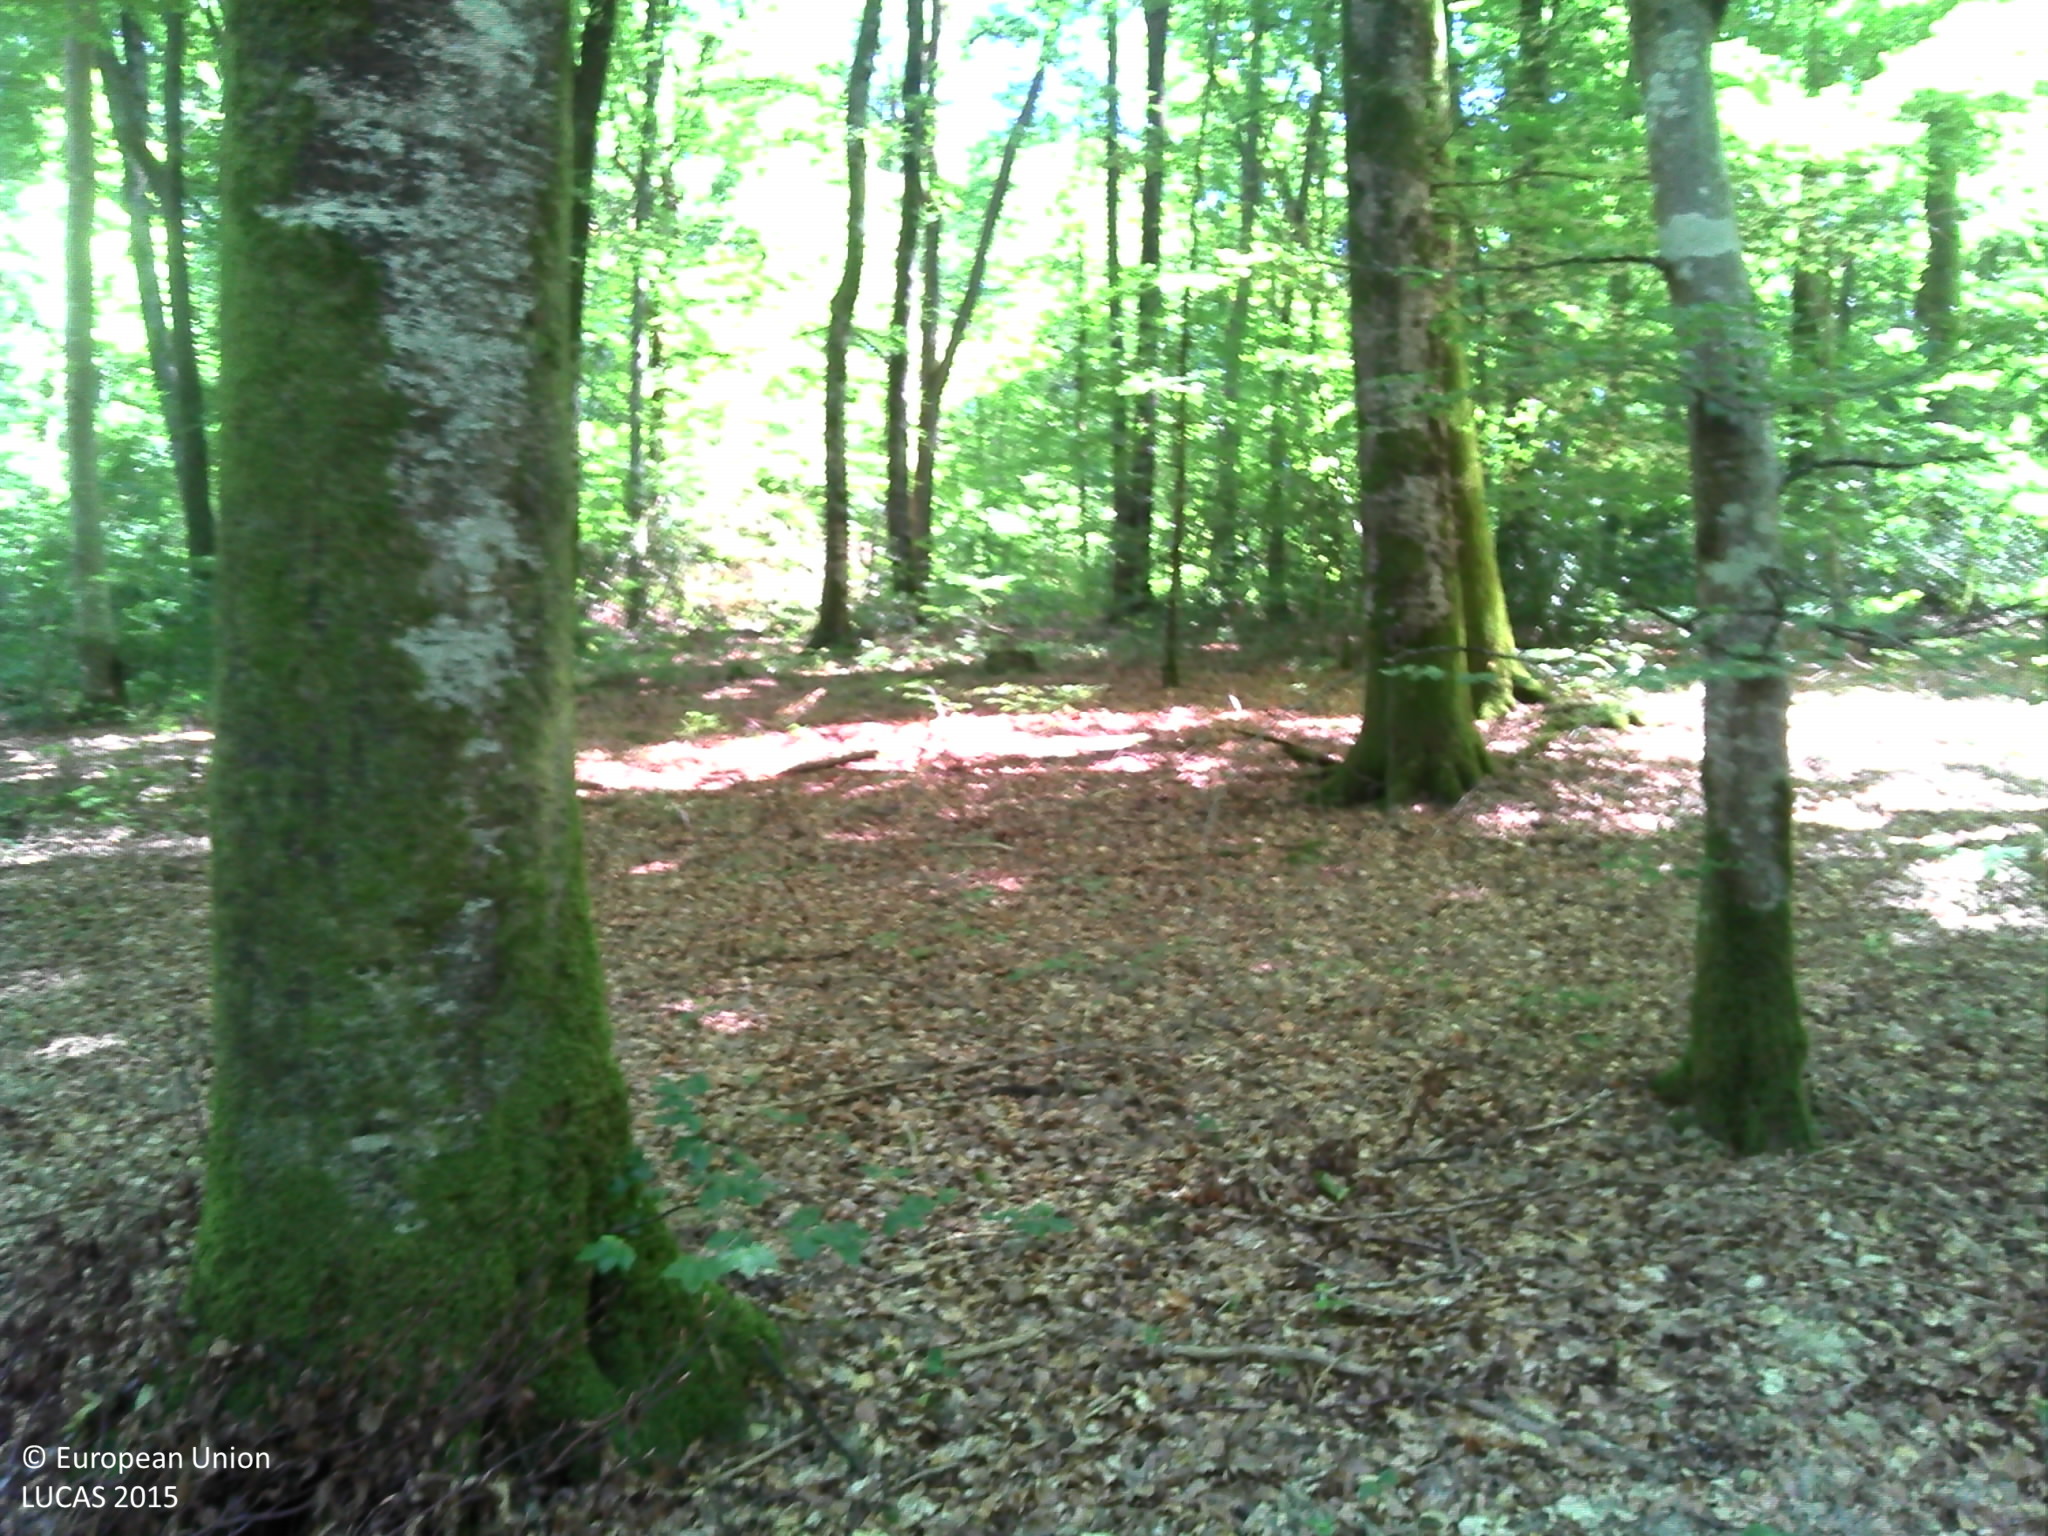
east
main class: Woodland
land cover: Broadleaved woodland
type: beech forest
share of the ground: > 75 %
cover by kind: broadleaved forest trees 90 %, consolidated bare surface 10 %
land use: Forestry
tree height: > 5 m
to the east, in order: Broadleaved woodland; Tracks; Broadleaved woodland
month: June
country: FR
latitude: 47.4723
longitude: 6.1670
